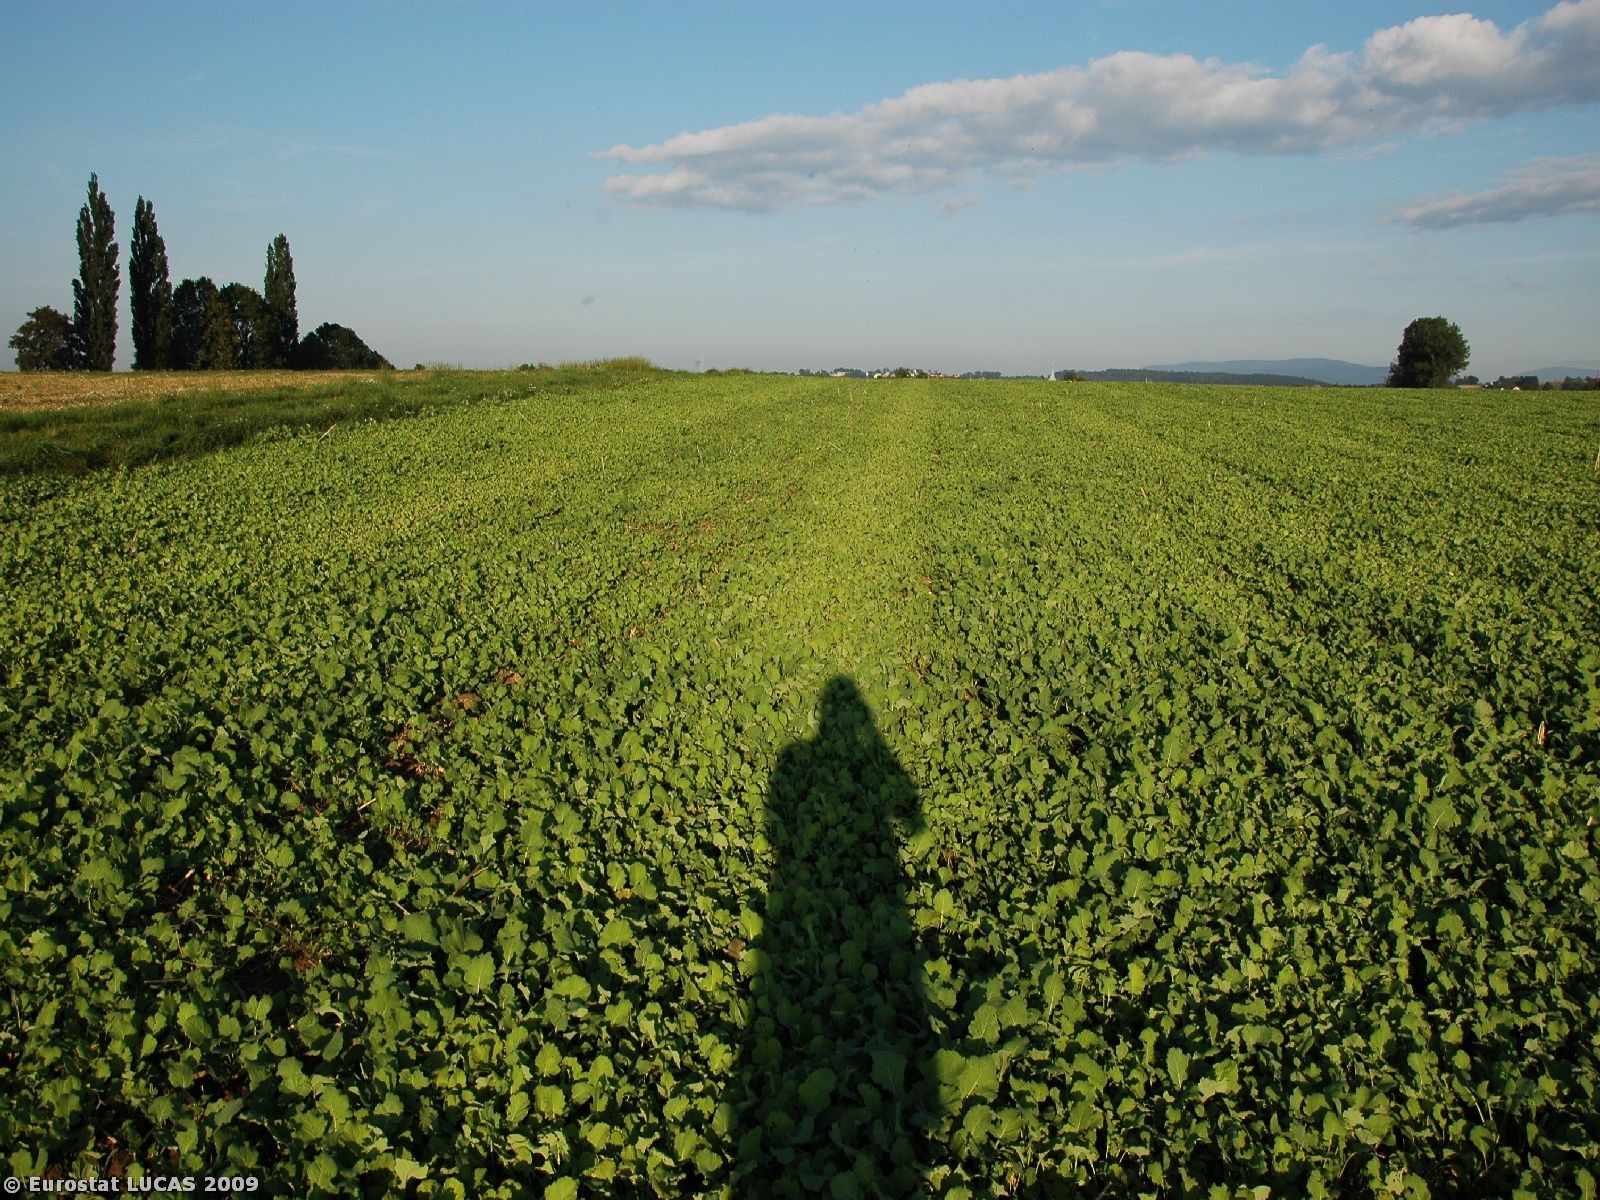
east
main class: Cropland
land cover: Rape and turnip rape
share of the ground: > 75 %
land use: Agriculture (excluding fallow land and kitchen gardens)
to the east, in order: Rape and turnip rape; Tracks; Grass margins; Mixed cereals for fodder; Grass margins; Rye
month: August
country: PL
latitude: 49.8145
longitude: 18.7063
